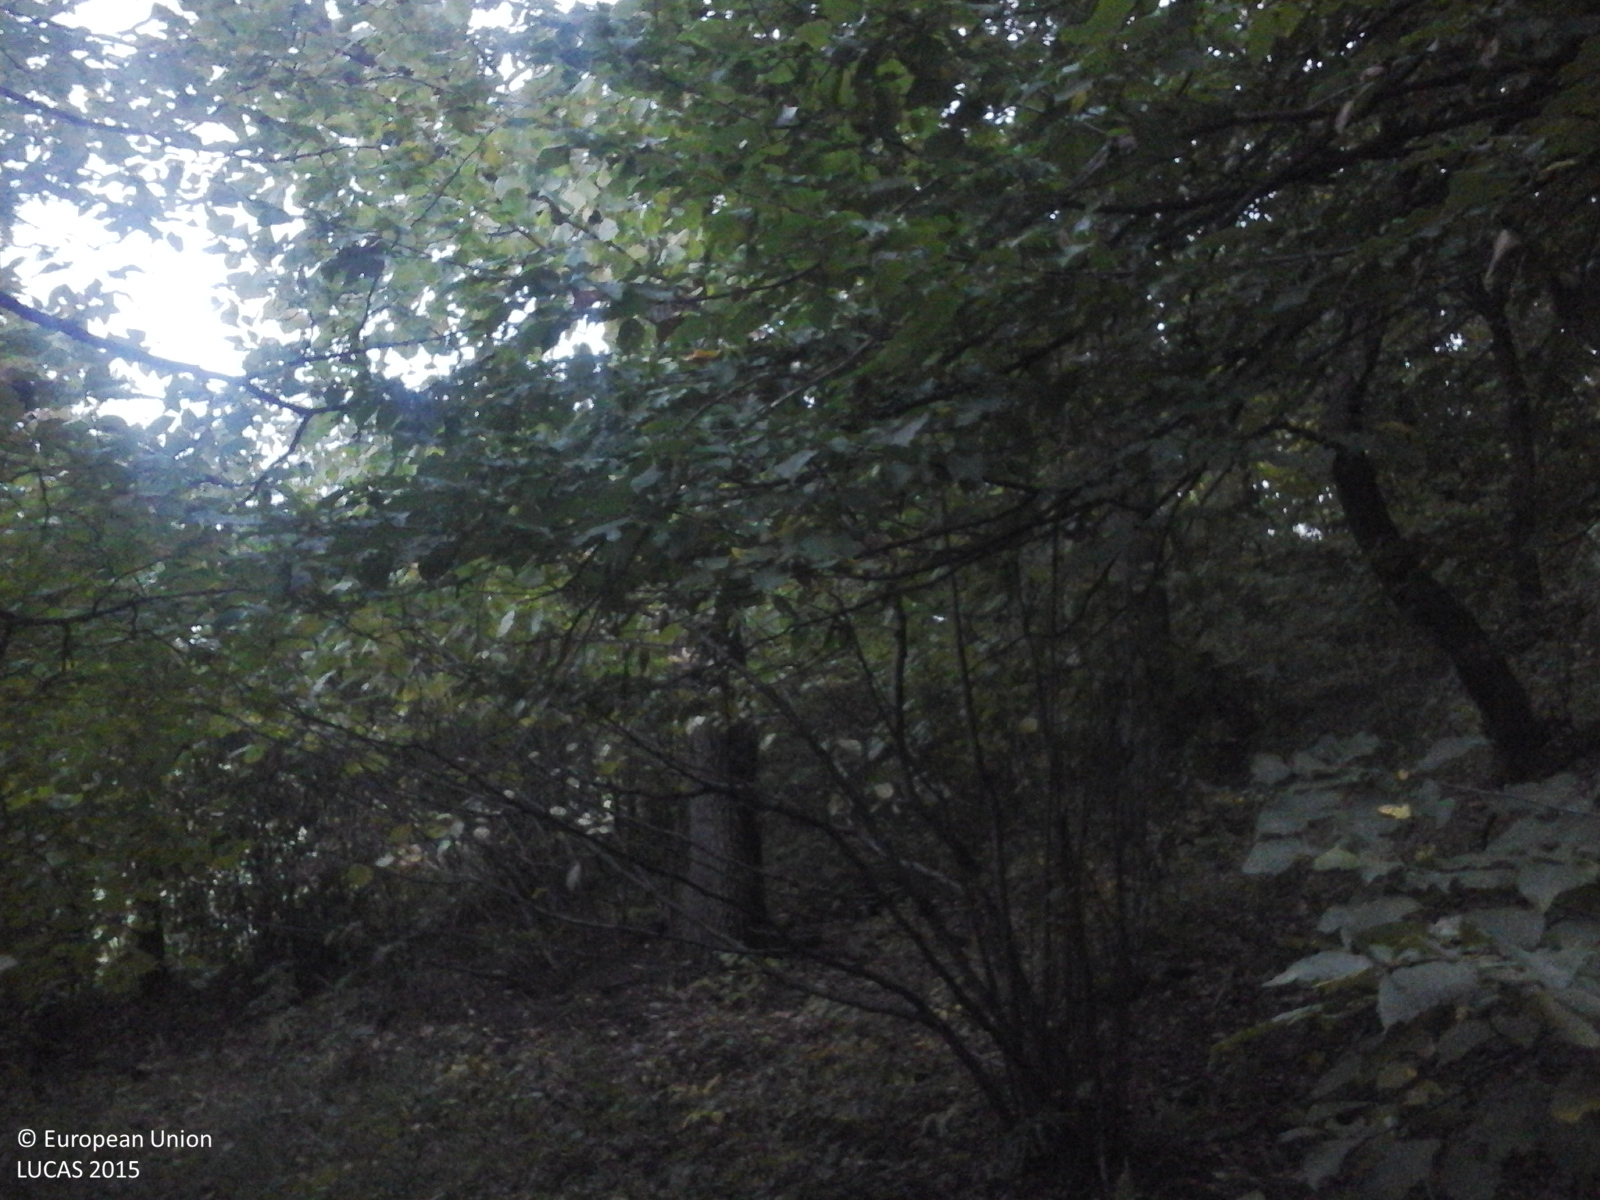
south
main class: Woodland
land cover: Broadleaved woodland
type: beech forest
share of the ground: > 75 %
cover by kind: broadleaved forest trees 100 %
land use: Forestry
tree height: > 5 m
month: October
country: RO
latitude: 46.2899
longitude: 25.2761
